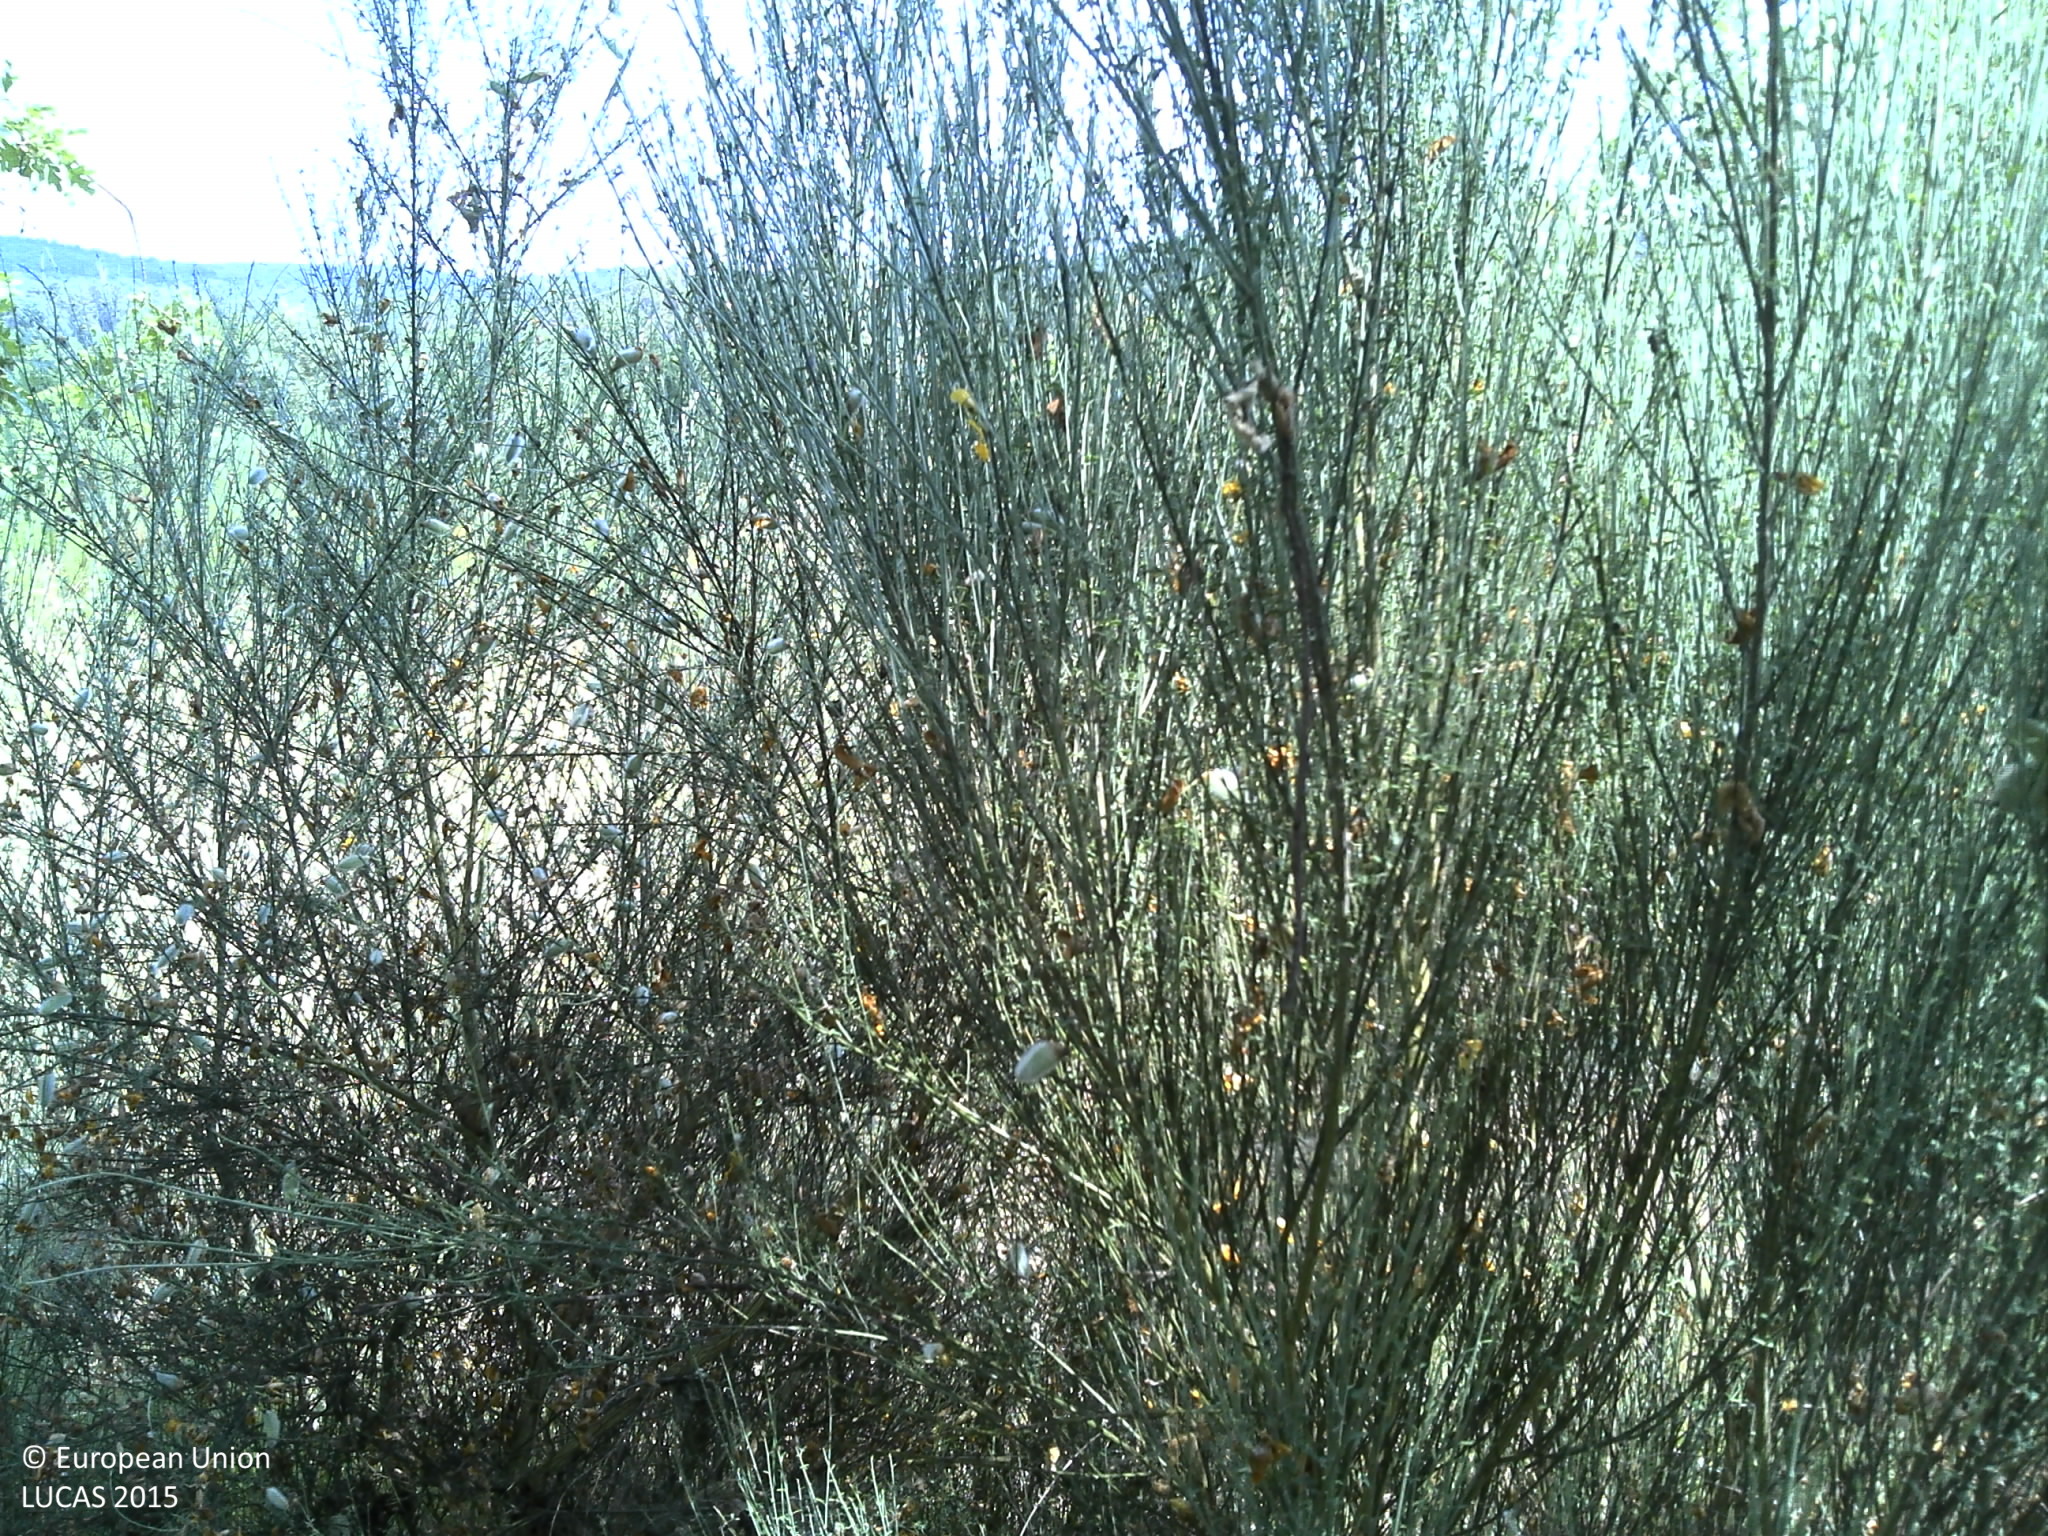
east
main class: Woodland
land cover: Broadleaved woodland
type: acidophilous oak and oak-birch forest
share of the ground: 25 - 50 %
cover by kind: herbaceous plants 60 %, broadleaved forest trees 25 %, shrubs 15 %
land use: Forestry
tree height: > 5 m
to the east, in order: Broadleaved woodland; Grassland without tree/shrub cover; Broadleaved woodland; Shrubland with sparse tree cover; Tracks; Broadleaved woodland; Nuts trees; Shrubland with sparse tree cover; Broadleaved woodland; Grassland without tree/shrub cover; Shruby margins; Fences; Grassland without tree/shrub cover; Broadleaved woodland; Rivers and streams; Grassland without tree/shrub cover
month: June
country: PT
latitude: 41.3457
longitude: -7.6614
